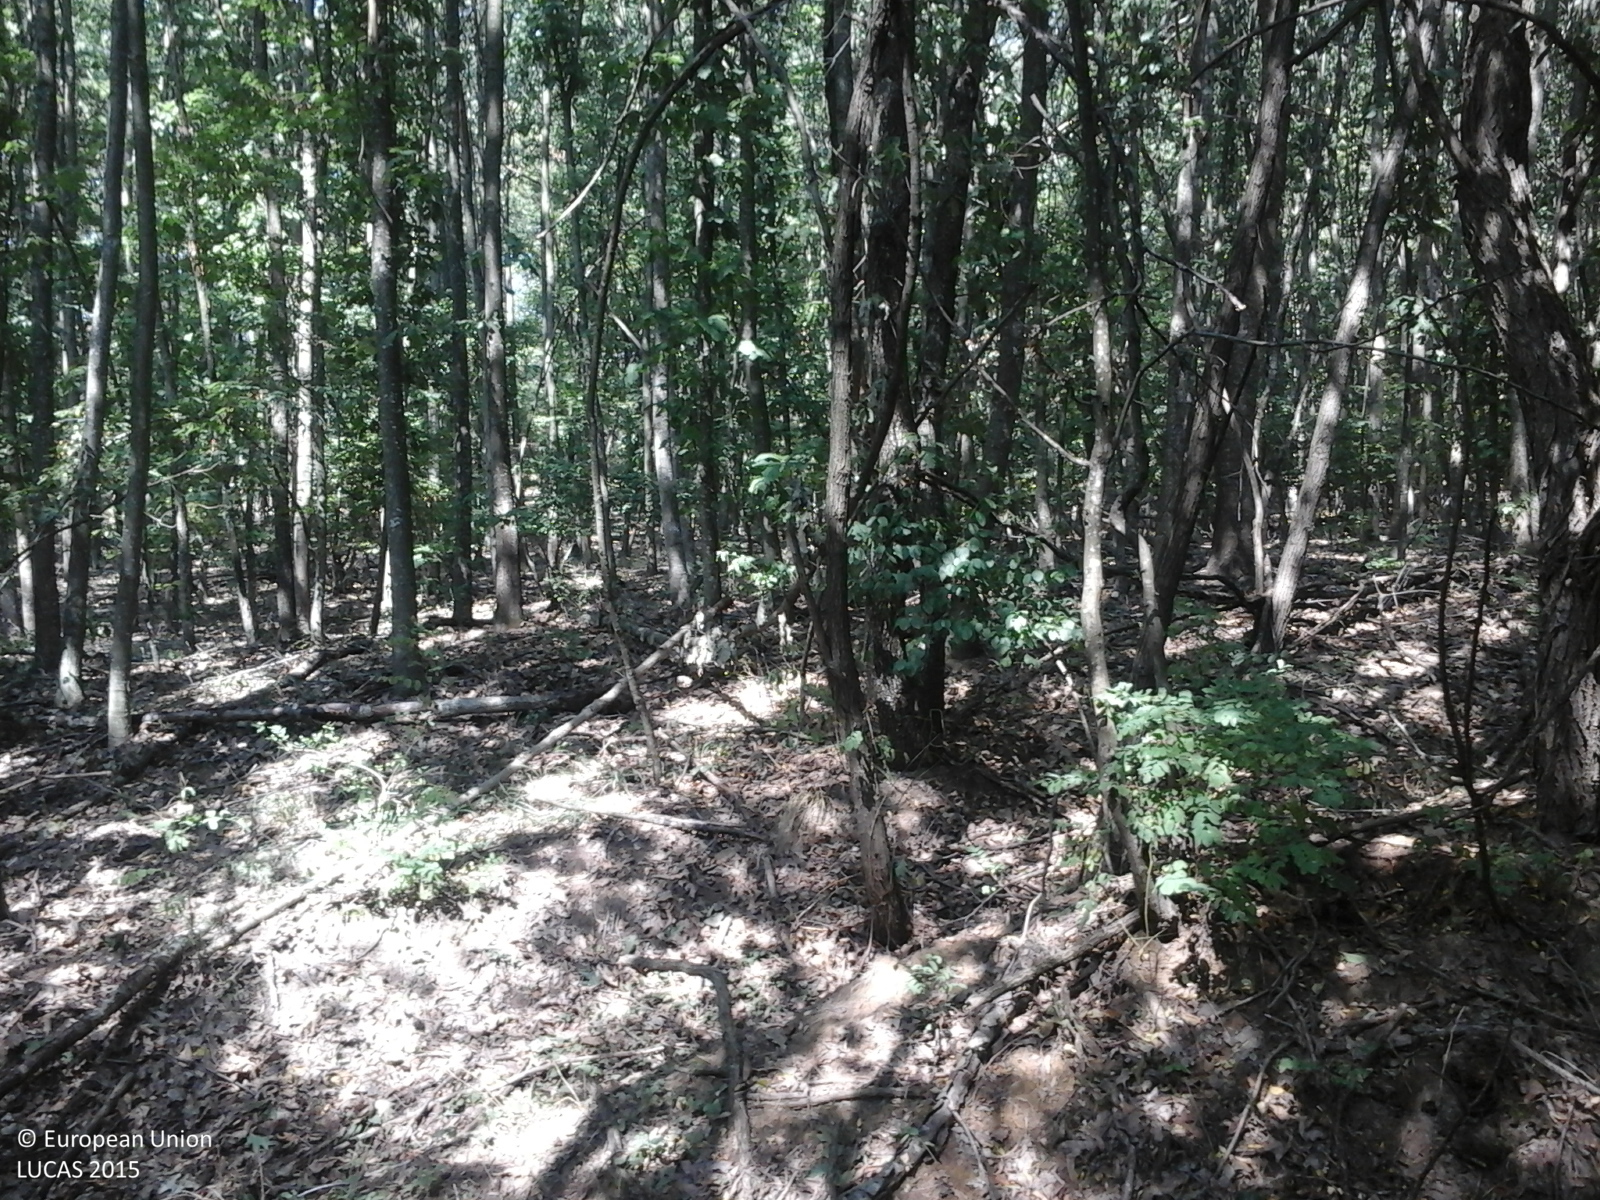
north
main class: Woodland
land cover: Broadleaved woodland
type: acidophilous oak and oak-birch forest
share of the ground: > 75 %
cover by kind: broadleaved forest trees 100 %
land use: Forestry
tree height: > 5 m
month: September
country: RO
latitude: 47.1088
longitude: 24.2520
